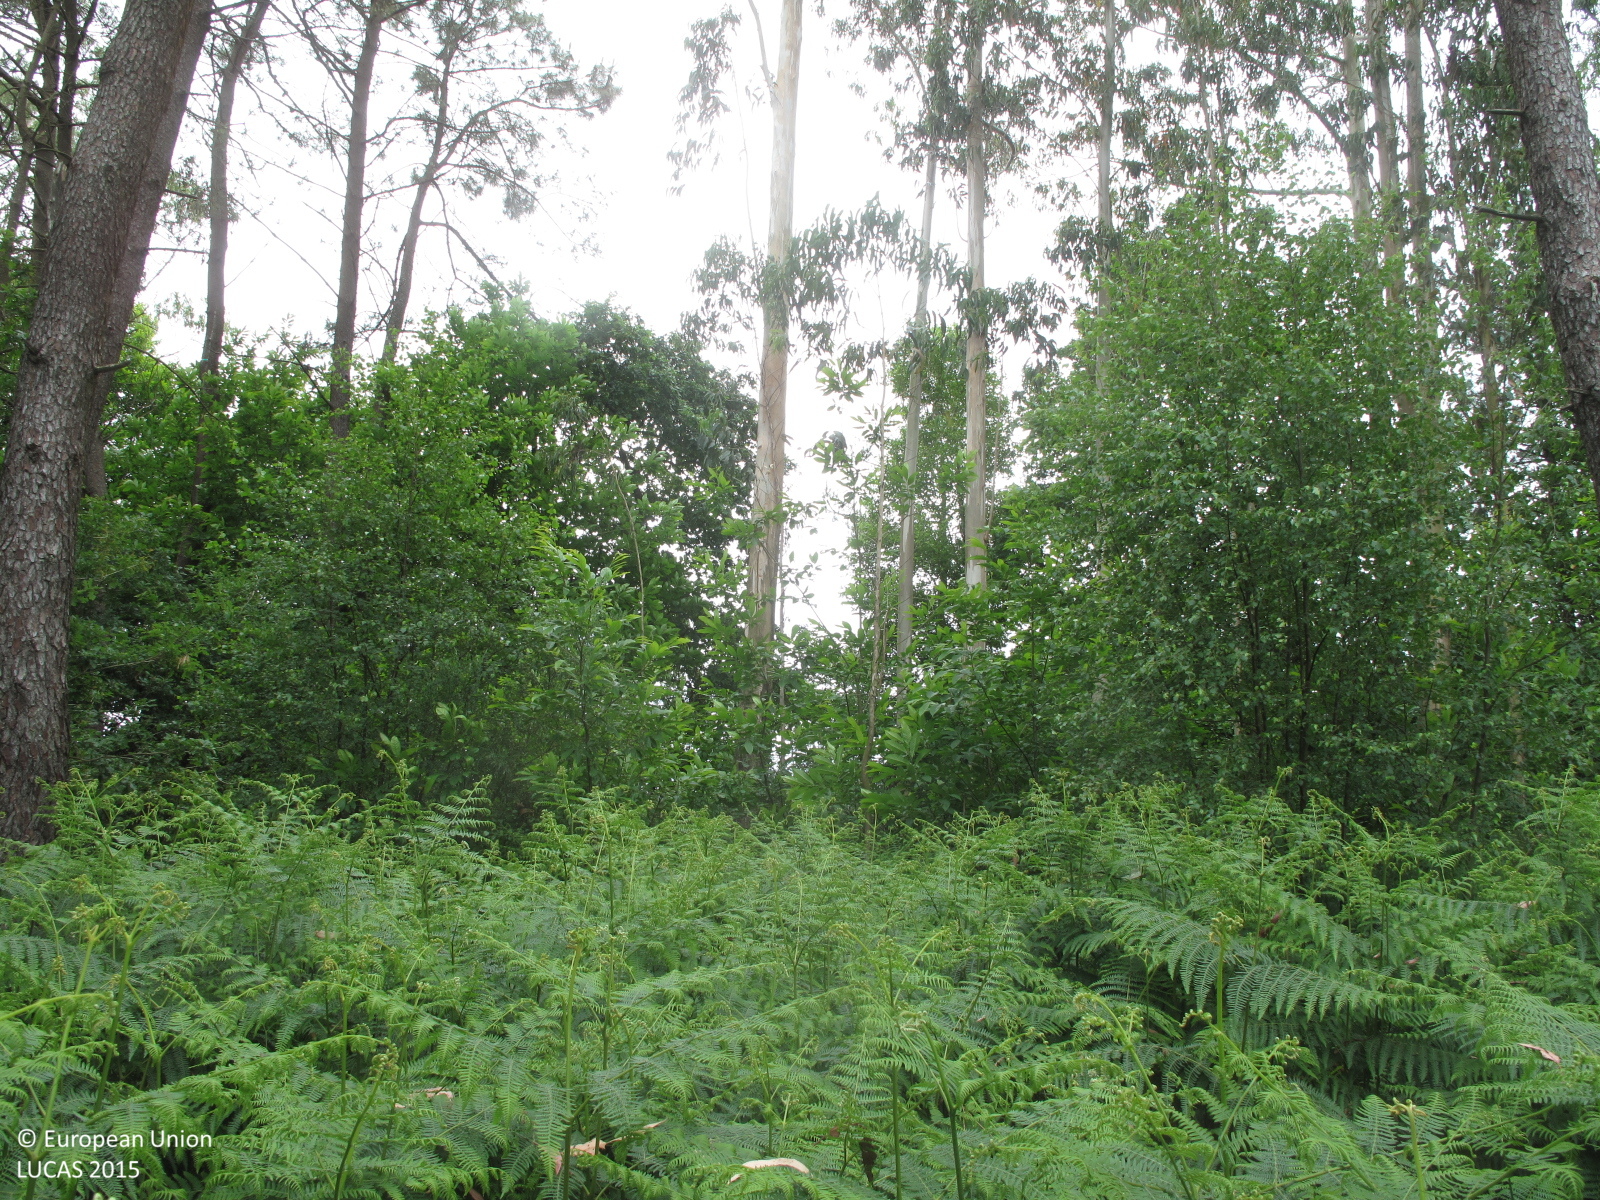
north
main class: Woodland
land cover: Other mixed woodland
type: exotic forest
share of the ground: > 75 %
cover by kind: broadleaved forest trees 40 %, coniferous forest trees 30 %, herbaceous plants 30 %
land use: Forestry
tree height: > 5 m
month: June
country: ES
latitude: 43.0506
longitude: -8.5343
